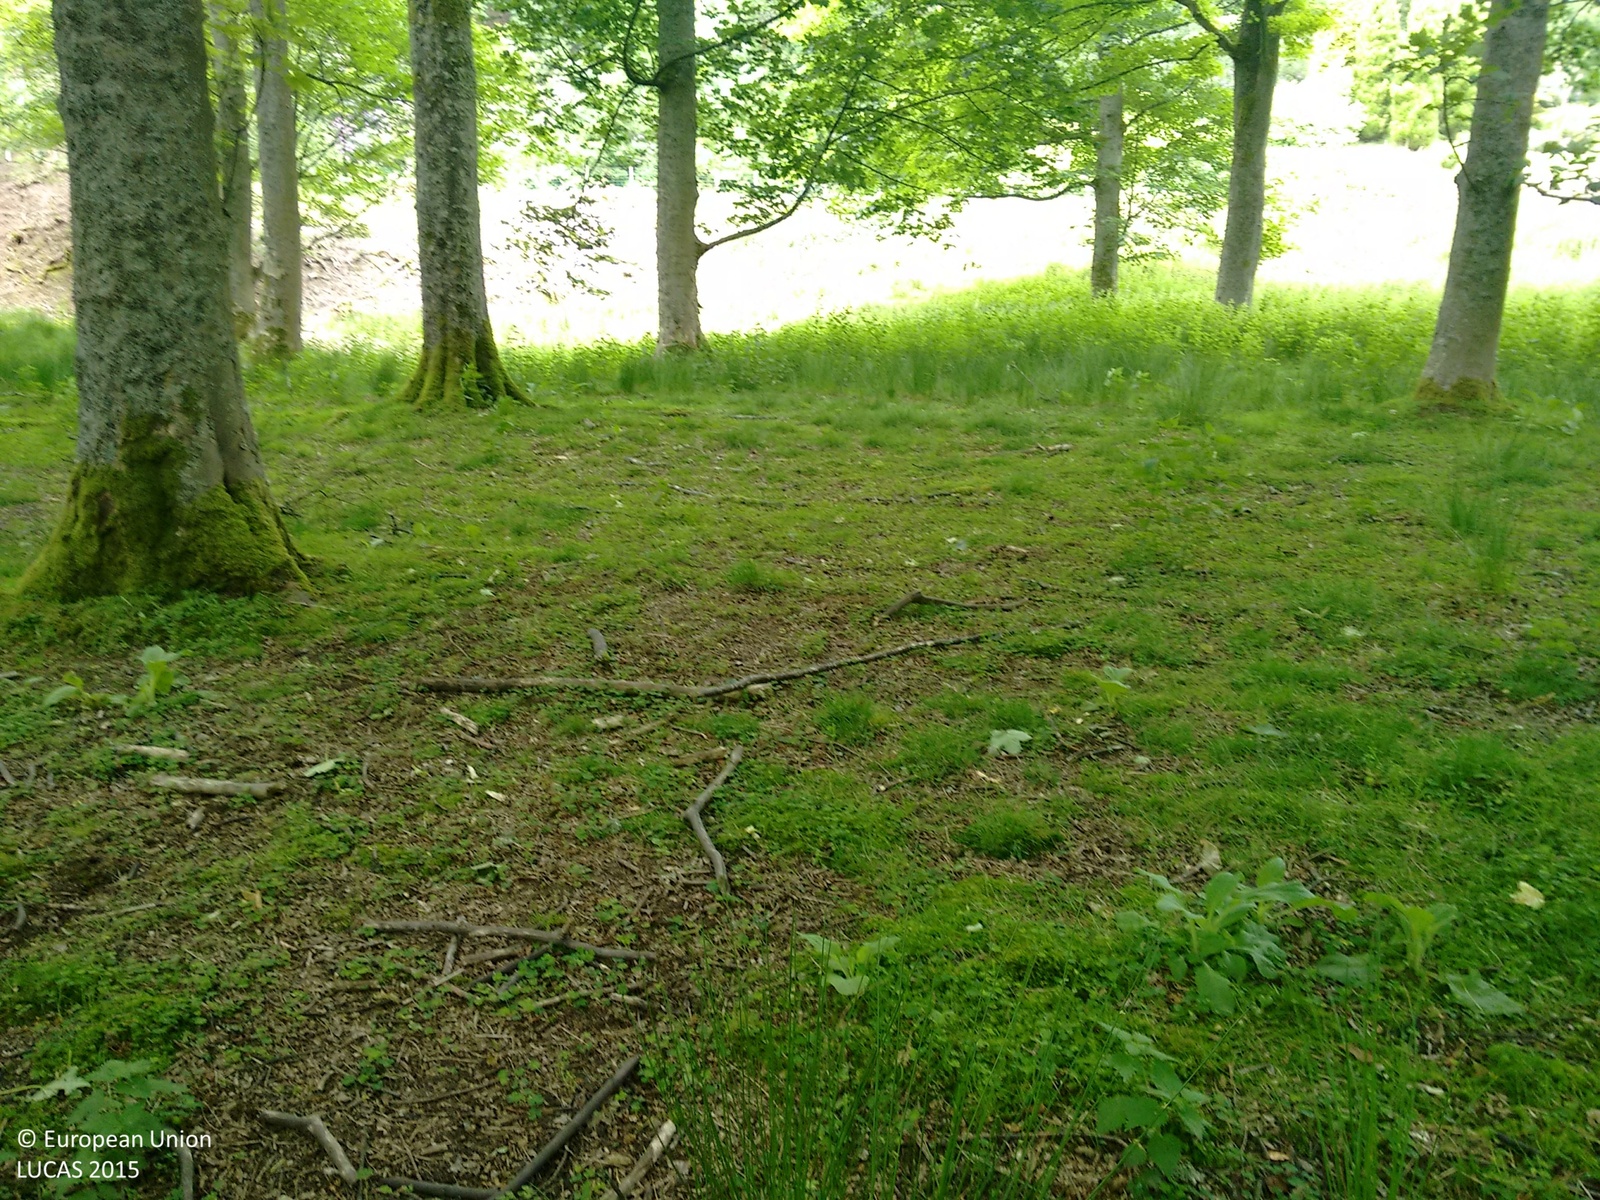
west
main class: Woodland
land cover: Broadleaved woodland
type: mesophytic deciduous forest
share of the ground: > 75 %
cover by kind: broadleaved forest trees 100 %
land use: Amenities, museums, leisure
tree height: > 5 m
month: June
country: GB
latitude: 53.4276
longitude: -1.7474
